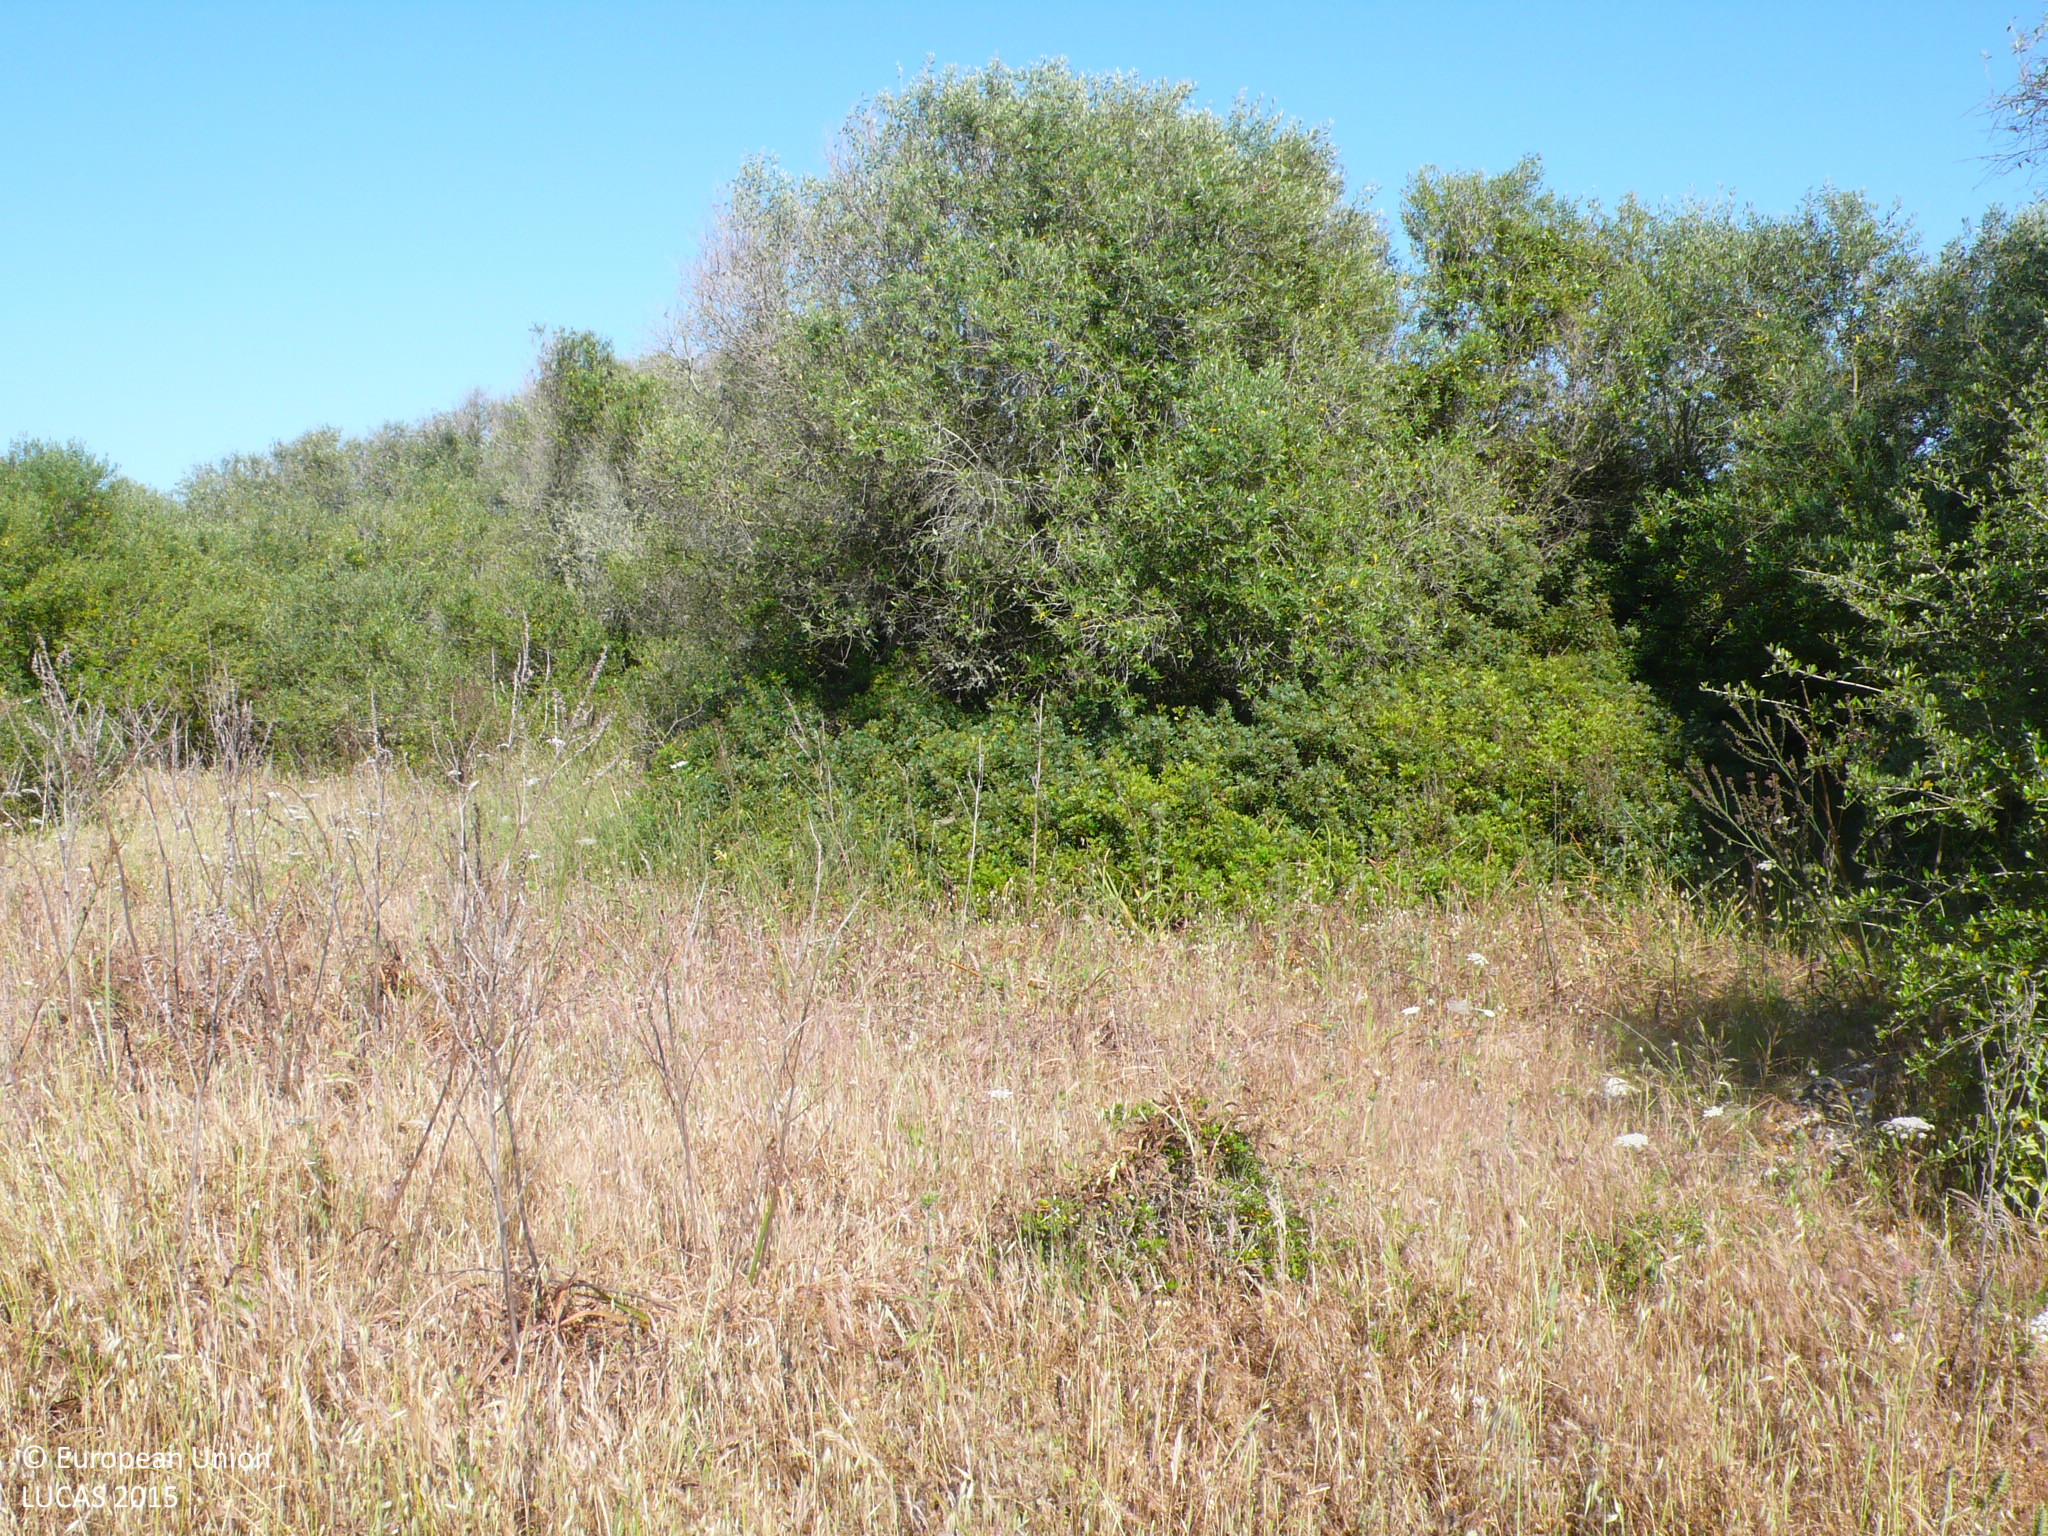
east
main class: Woodland
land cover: Broadleaved woodland
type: broadleaved evergreen forest
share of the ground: 25 - 50 %
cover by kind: herbaceous plants 50 %, broadleaved forest trees 30 %, shrubs 20 %
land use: Semi-natural and natural areas not in use
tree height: < 5 m
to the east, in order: Broadleaved woodland; Dry stone walls; Broadleaved woodland; Dry stone walls; Barley; Broadleaved woodland; Dry stone walls; Broadleaved woodland; Oats
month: May
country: ES
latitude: 39.8774
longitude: 4.1918
